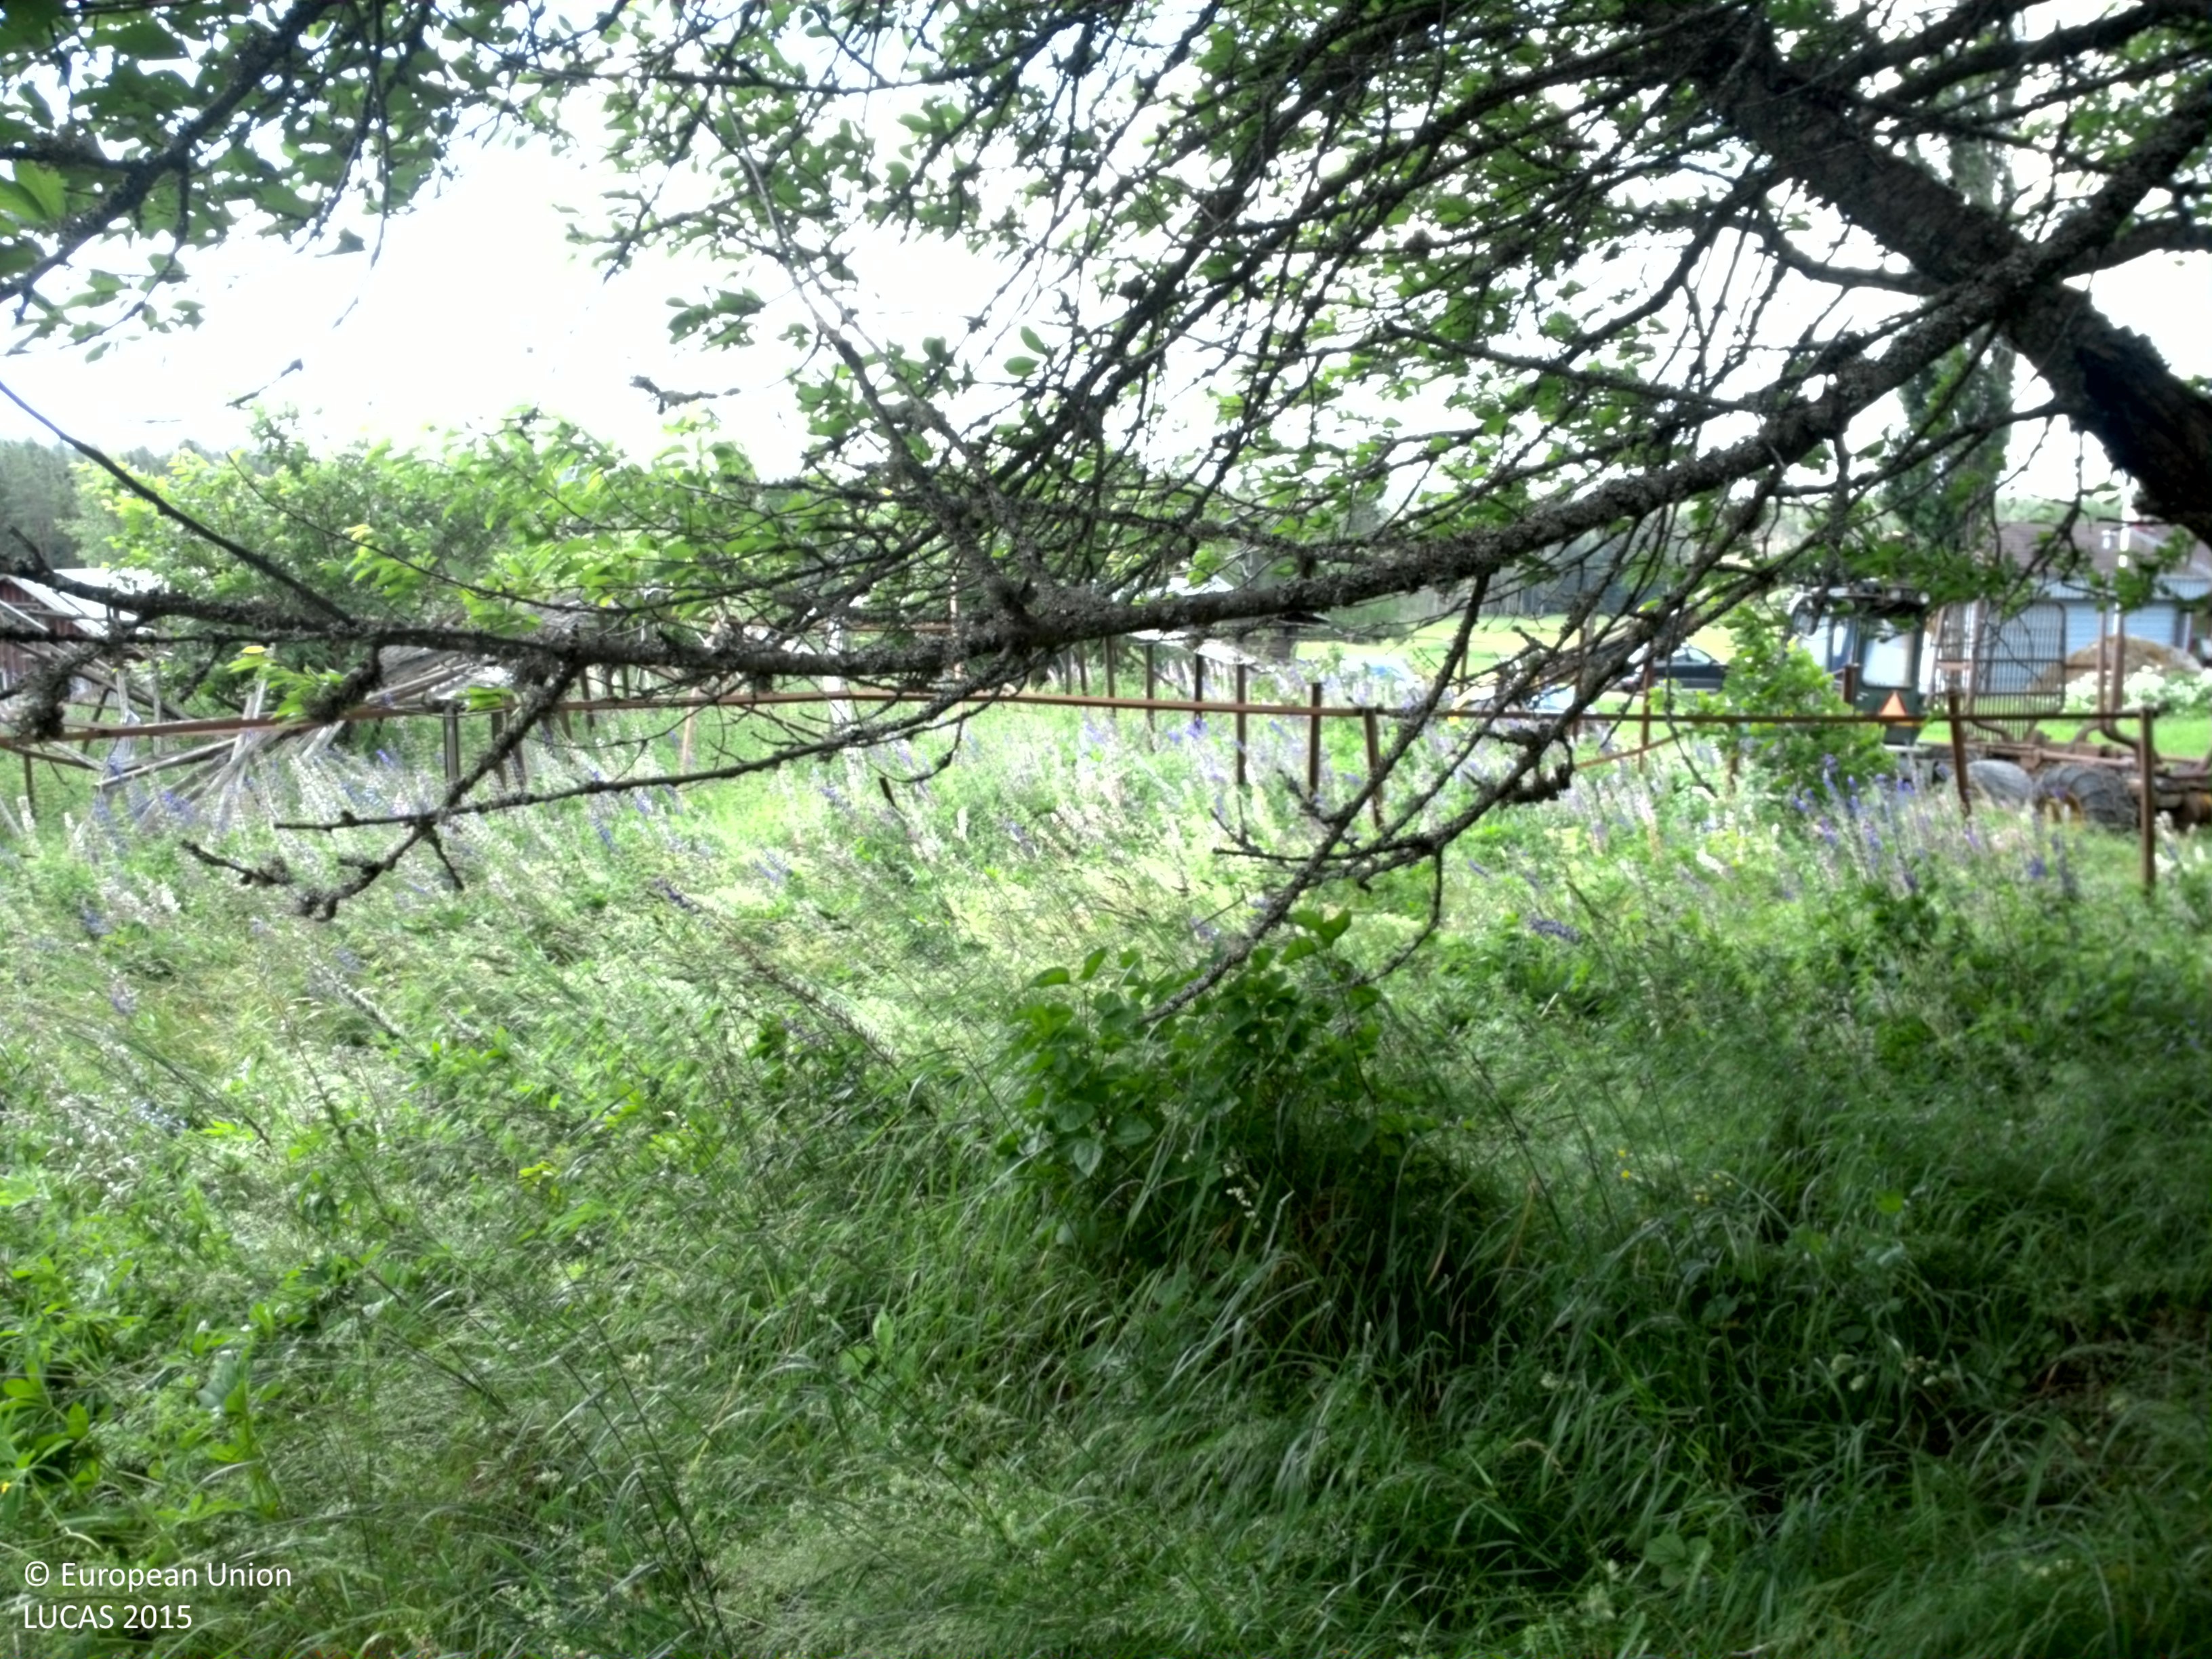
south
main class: Grassland
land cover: Spontaneously vegetated surfaces
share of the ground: > 75 %
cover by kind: herbaceous plants 100 %
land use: Semi-natural and natural areas not in use
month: July
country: SE
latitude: 58.8251
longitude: 14.6171
